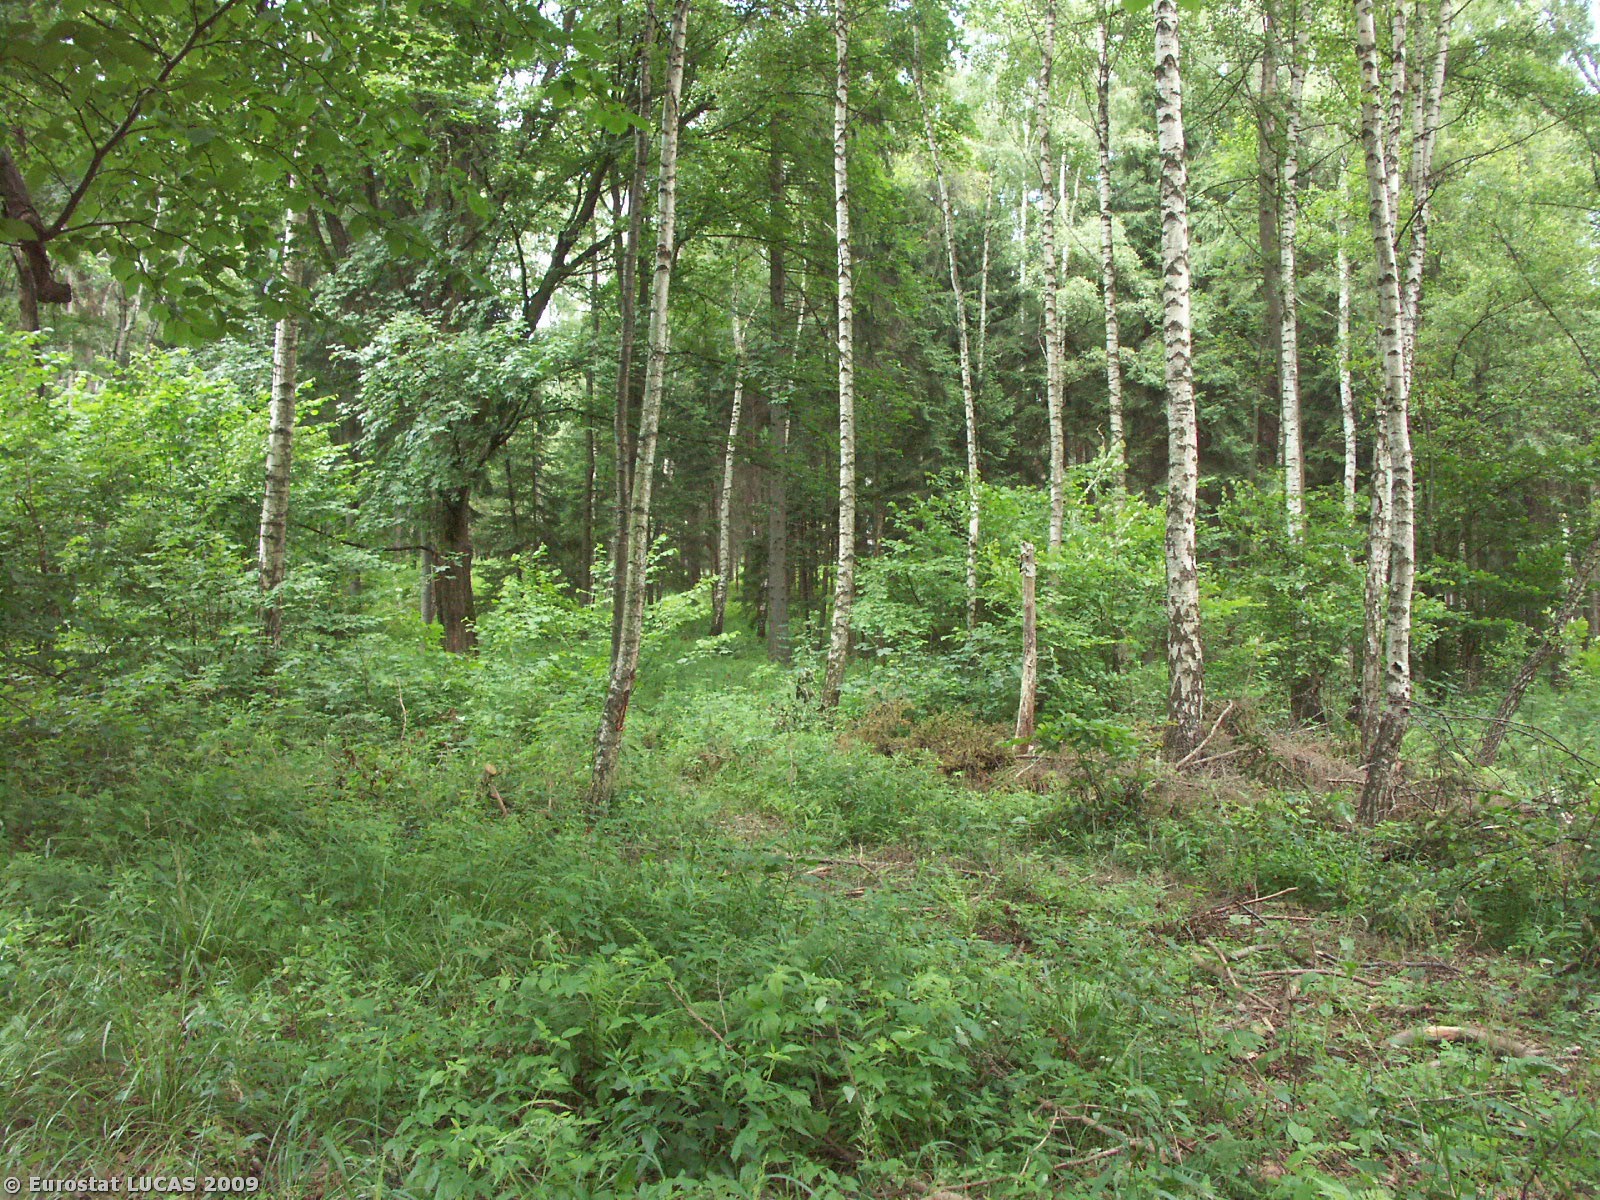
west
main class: Woodland
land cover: Mixed woodland
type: hemiboreal forest and nemoral coniferous forest and mixed broadleaved-coniferous forest
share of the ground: > 75 %
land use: Forestry
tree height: > 5 m
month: July
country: CZ
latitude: 49.8586
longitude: 17.5939
